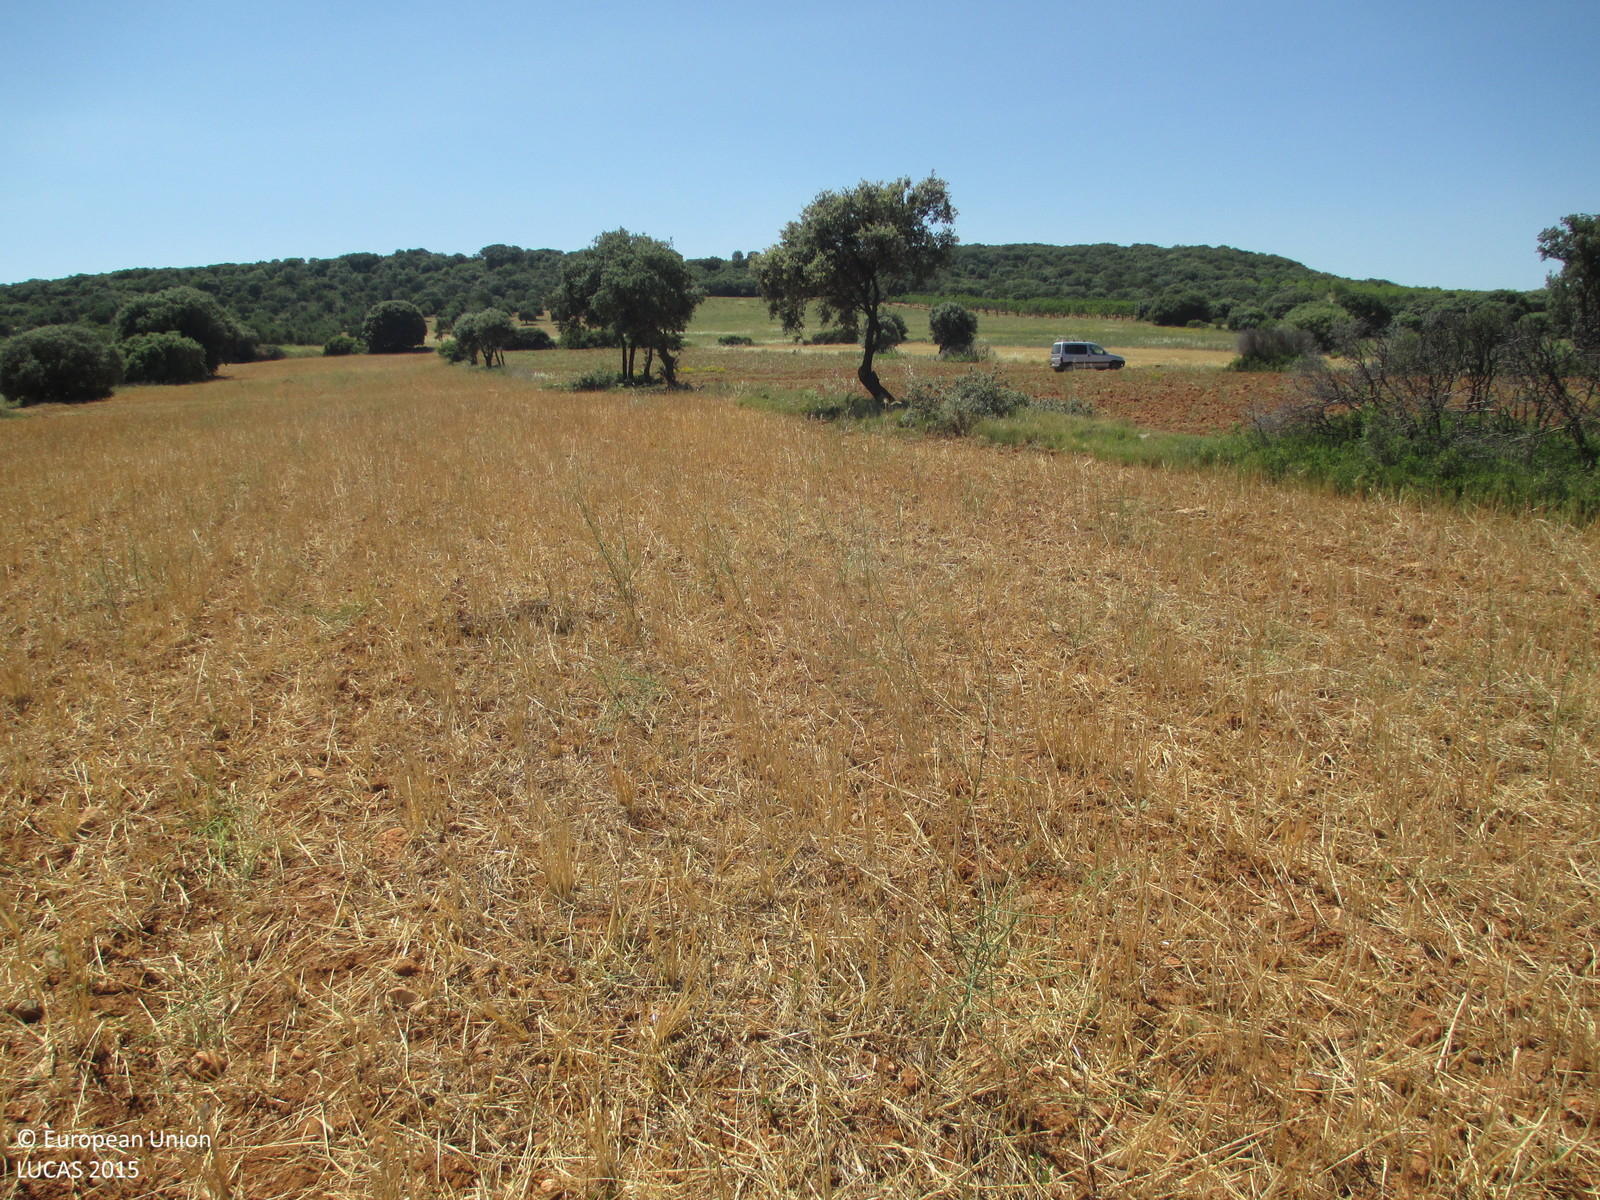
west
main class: Cropland
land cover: Barley
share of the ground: < 10 %
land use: Agriculture (excluding fallow land and kitchen gardens)
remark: Harvested field
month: June
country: ES
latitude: 42.1845
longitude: -0.2774
